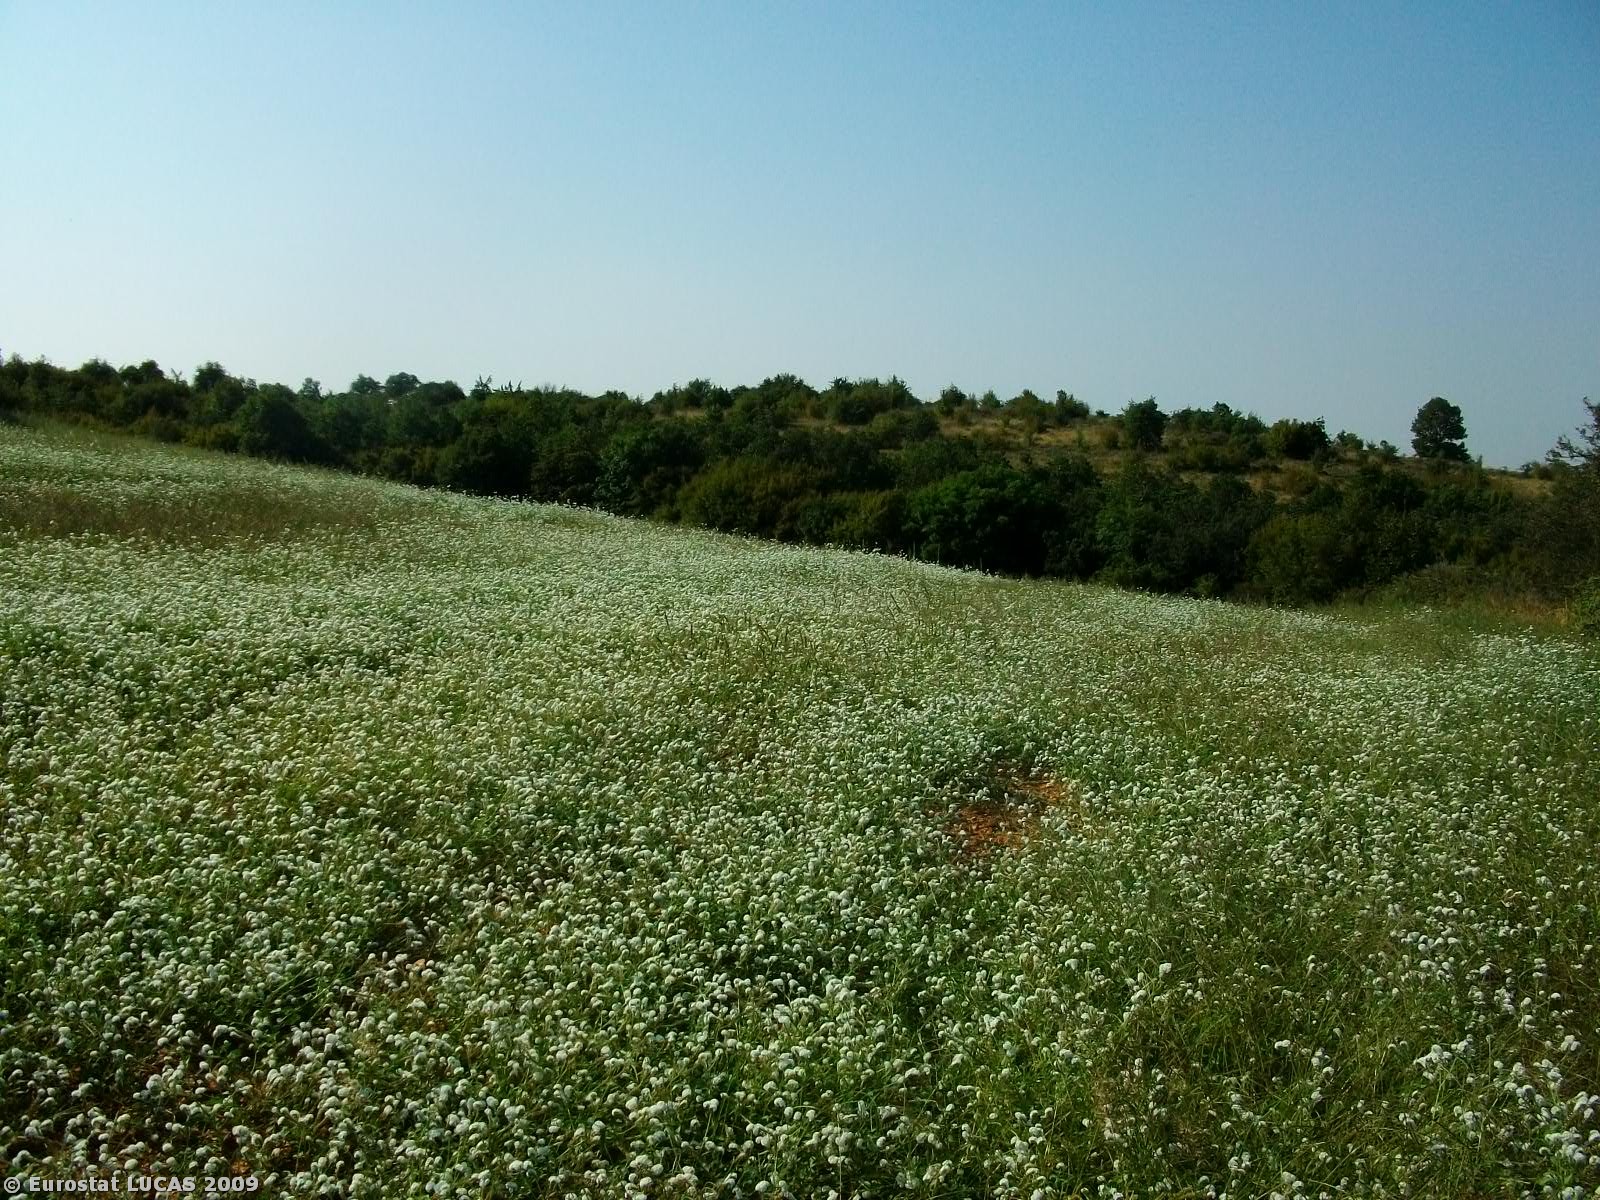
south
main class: Grassland
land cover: Spontaneously vegetated surfaces
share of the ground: > 75 %
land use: Fallow land
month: August
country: GR
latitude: 41.1385
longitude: 22.8425
